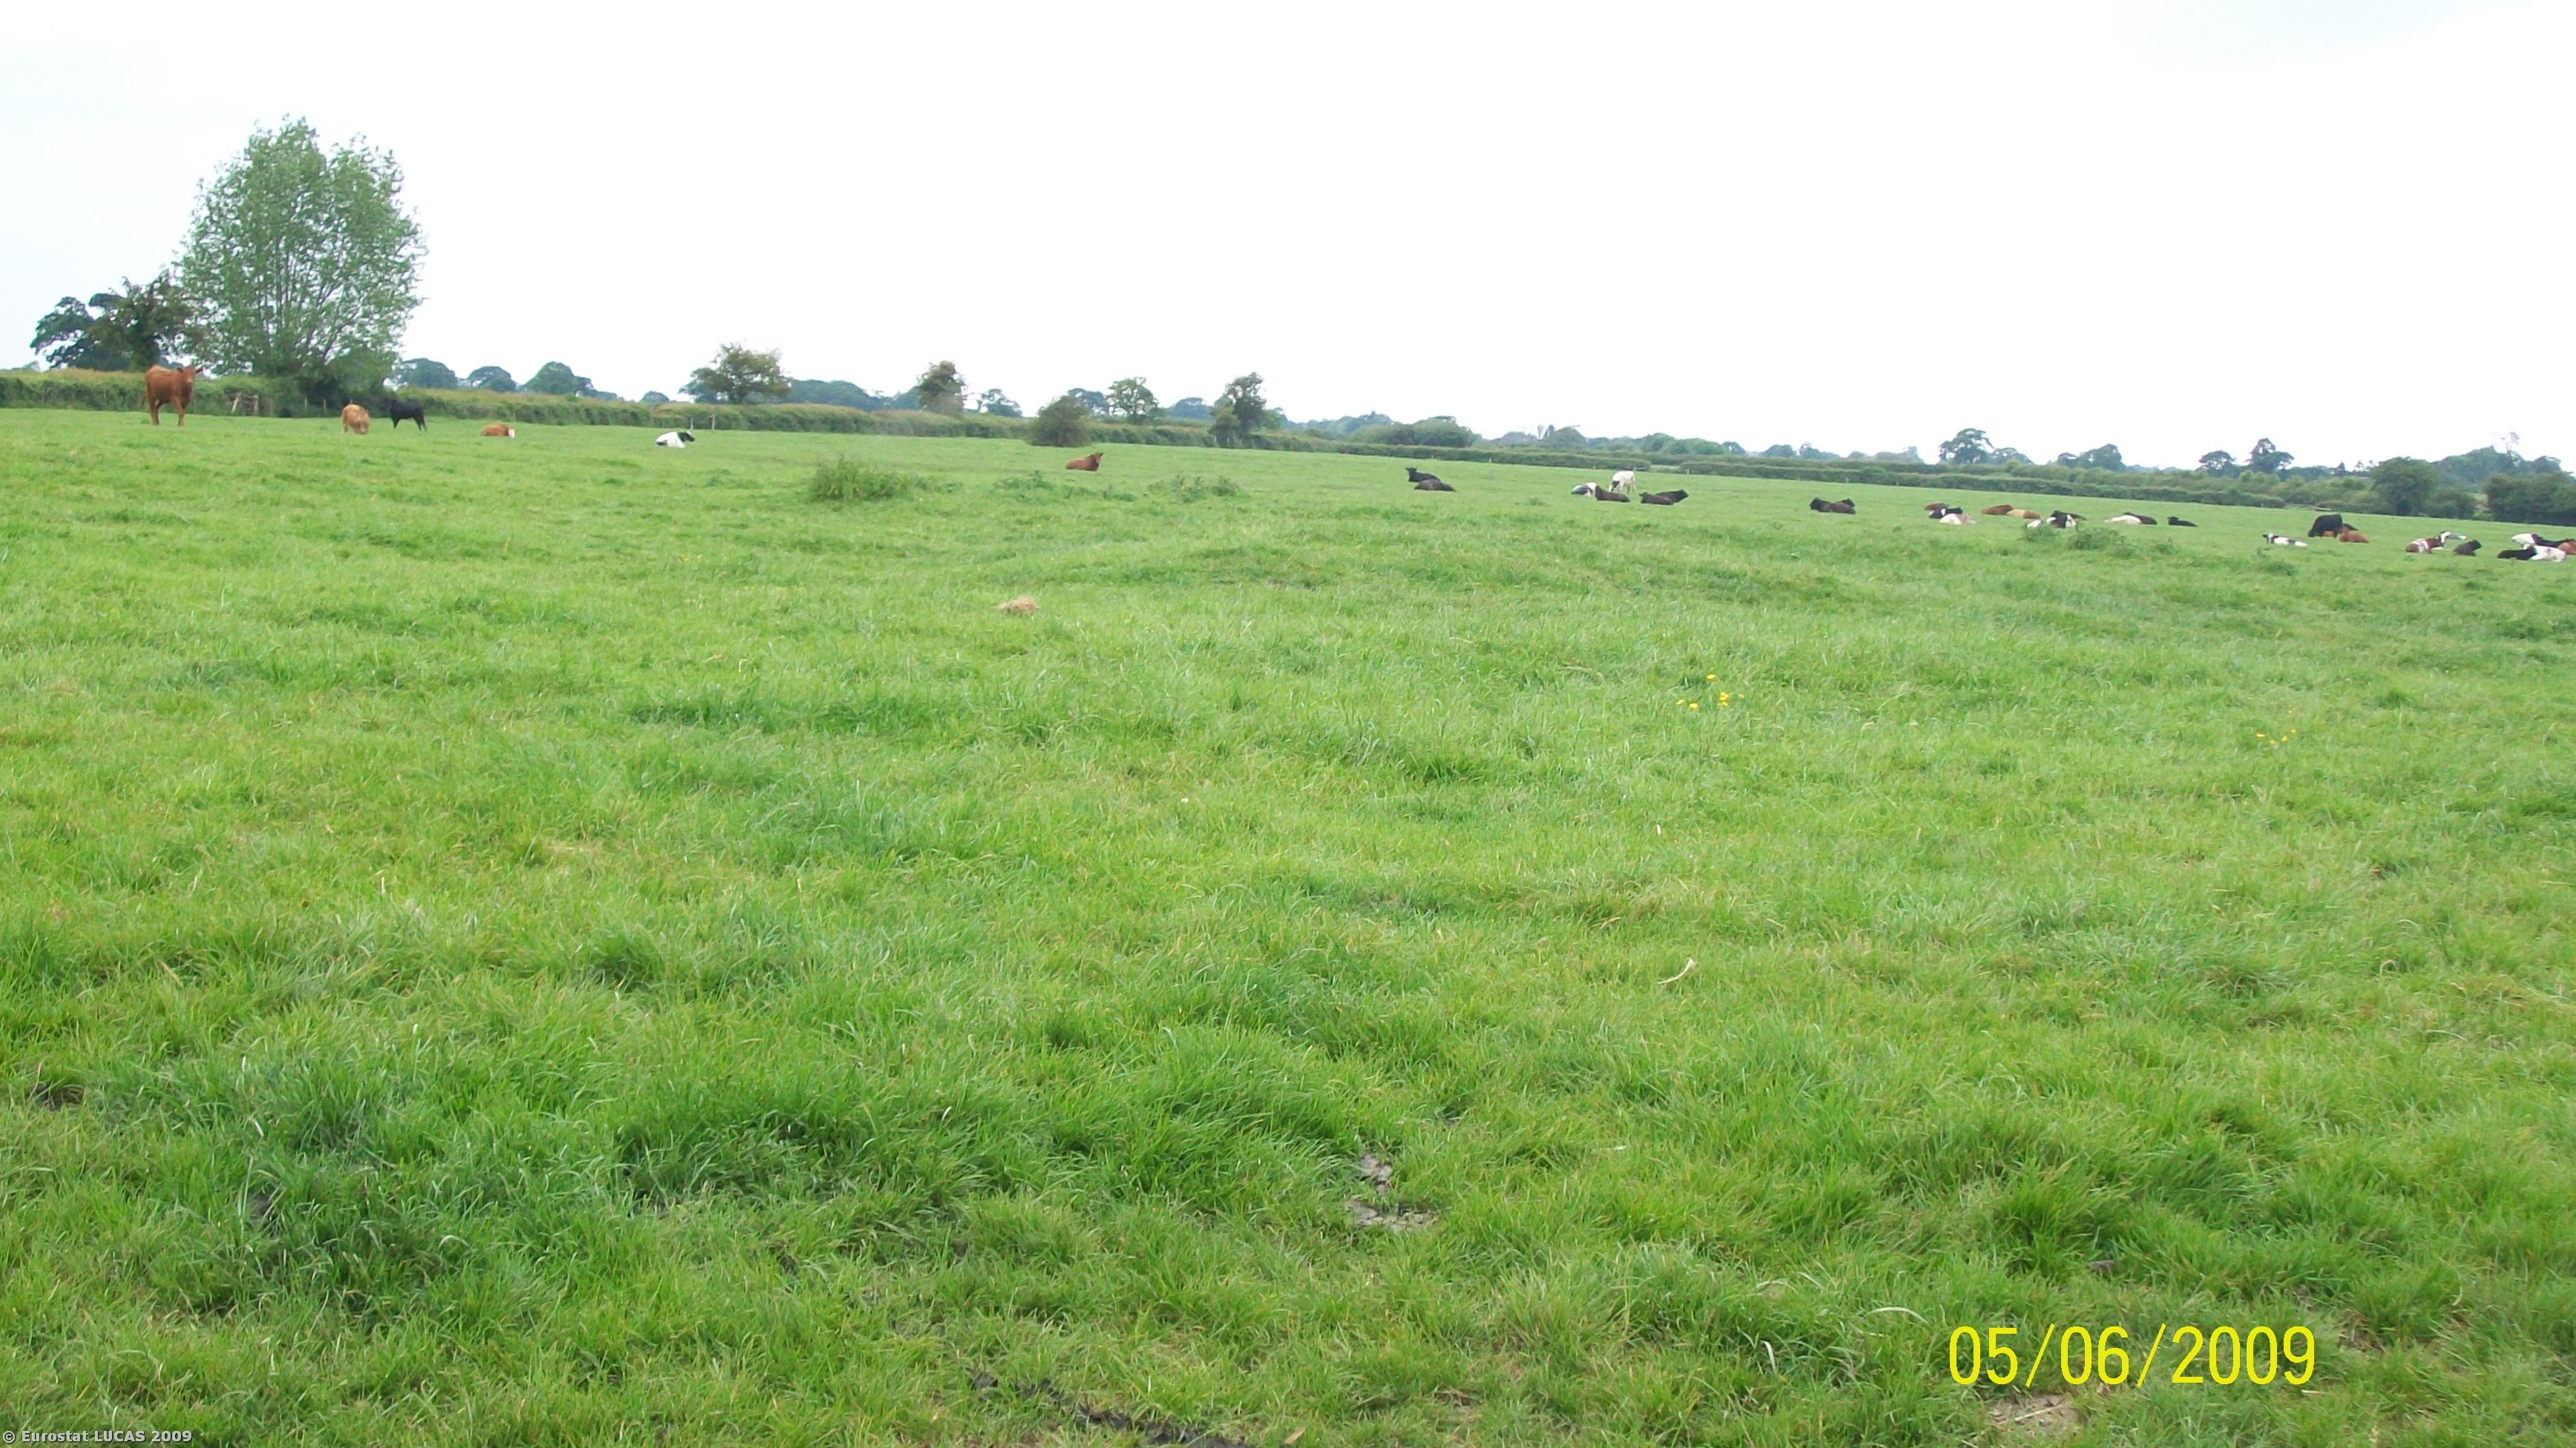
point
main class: Grassland
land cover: Grassland without tree/shrub cover
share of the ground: > 75 %
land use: Agriculture (excluding fallow land and kitchen gardens)
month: June
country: GB
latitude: 53.1596
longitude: -2.7679
